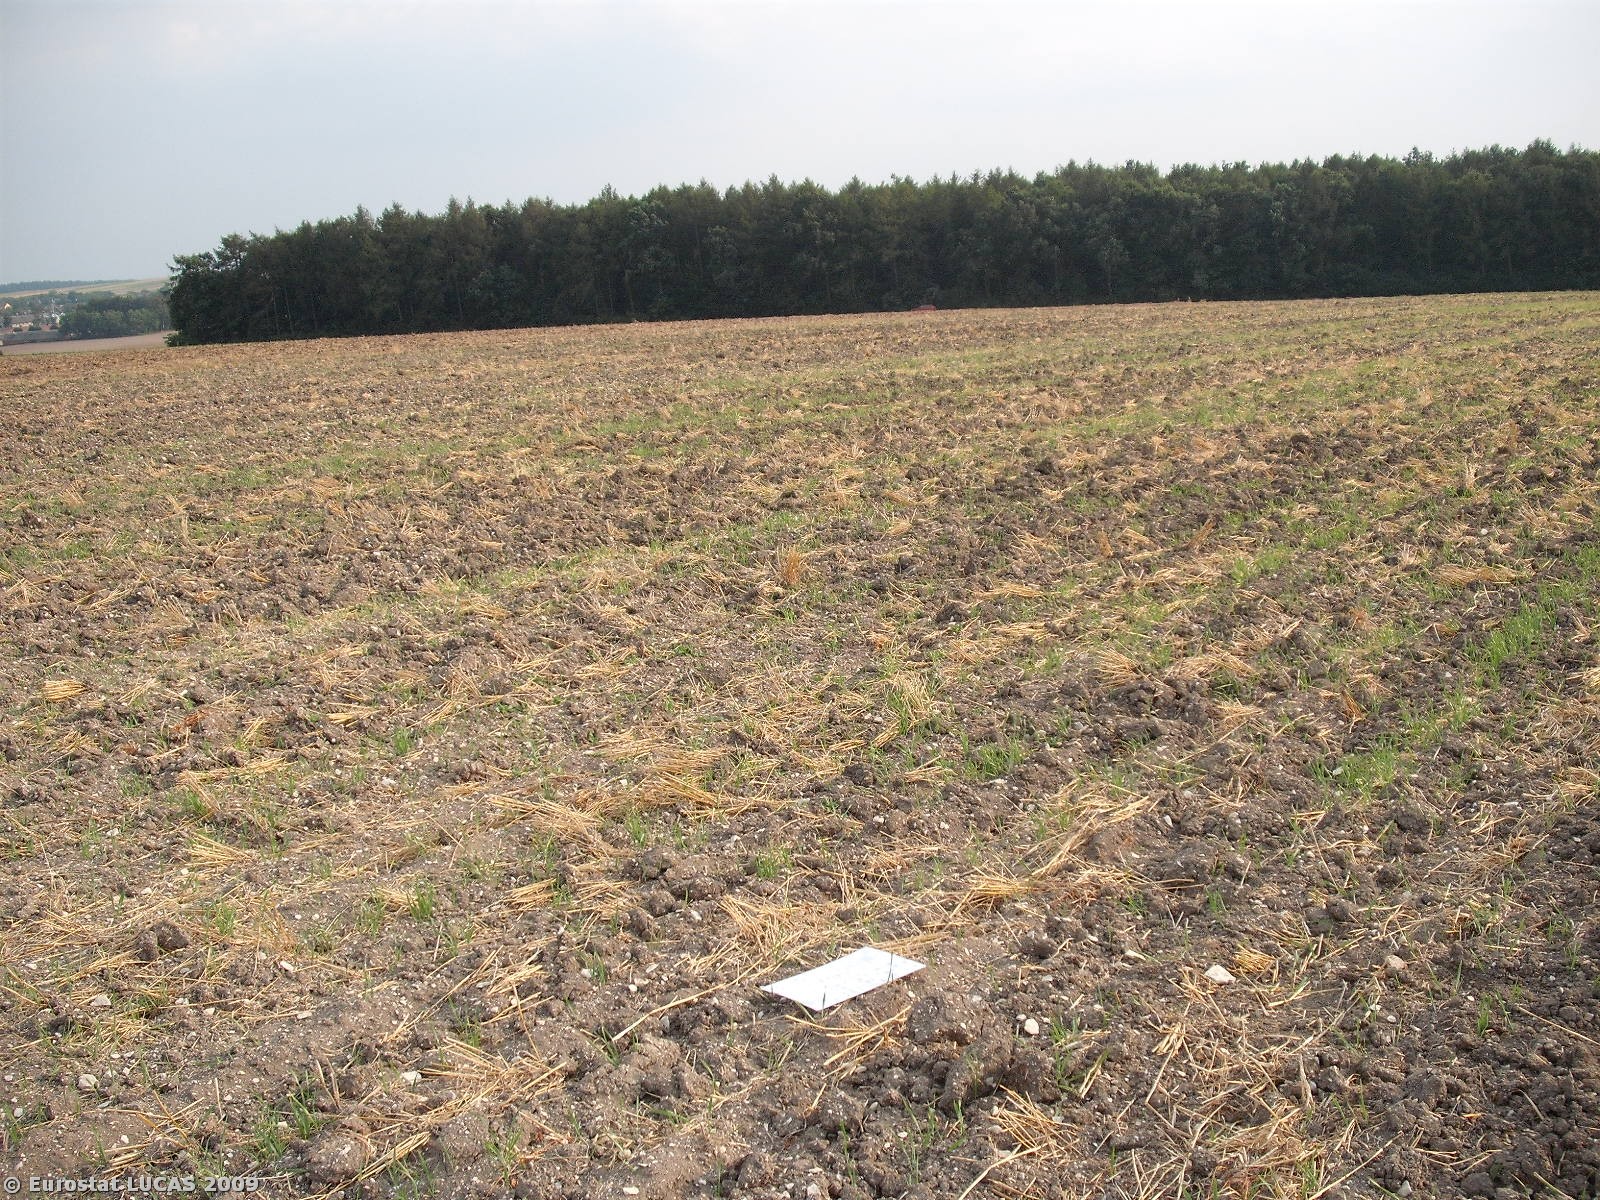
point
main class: Cropland
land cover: Barley
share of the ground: < 10 %
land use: Agriculture (excluding fallow land and kitchen gardens)
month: September
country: PL
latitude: 50.4772
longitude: 20.3086
